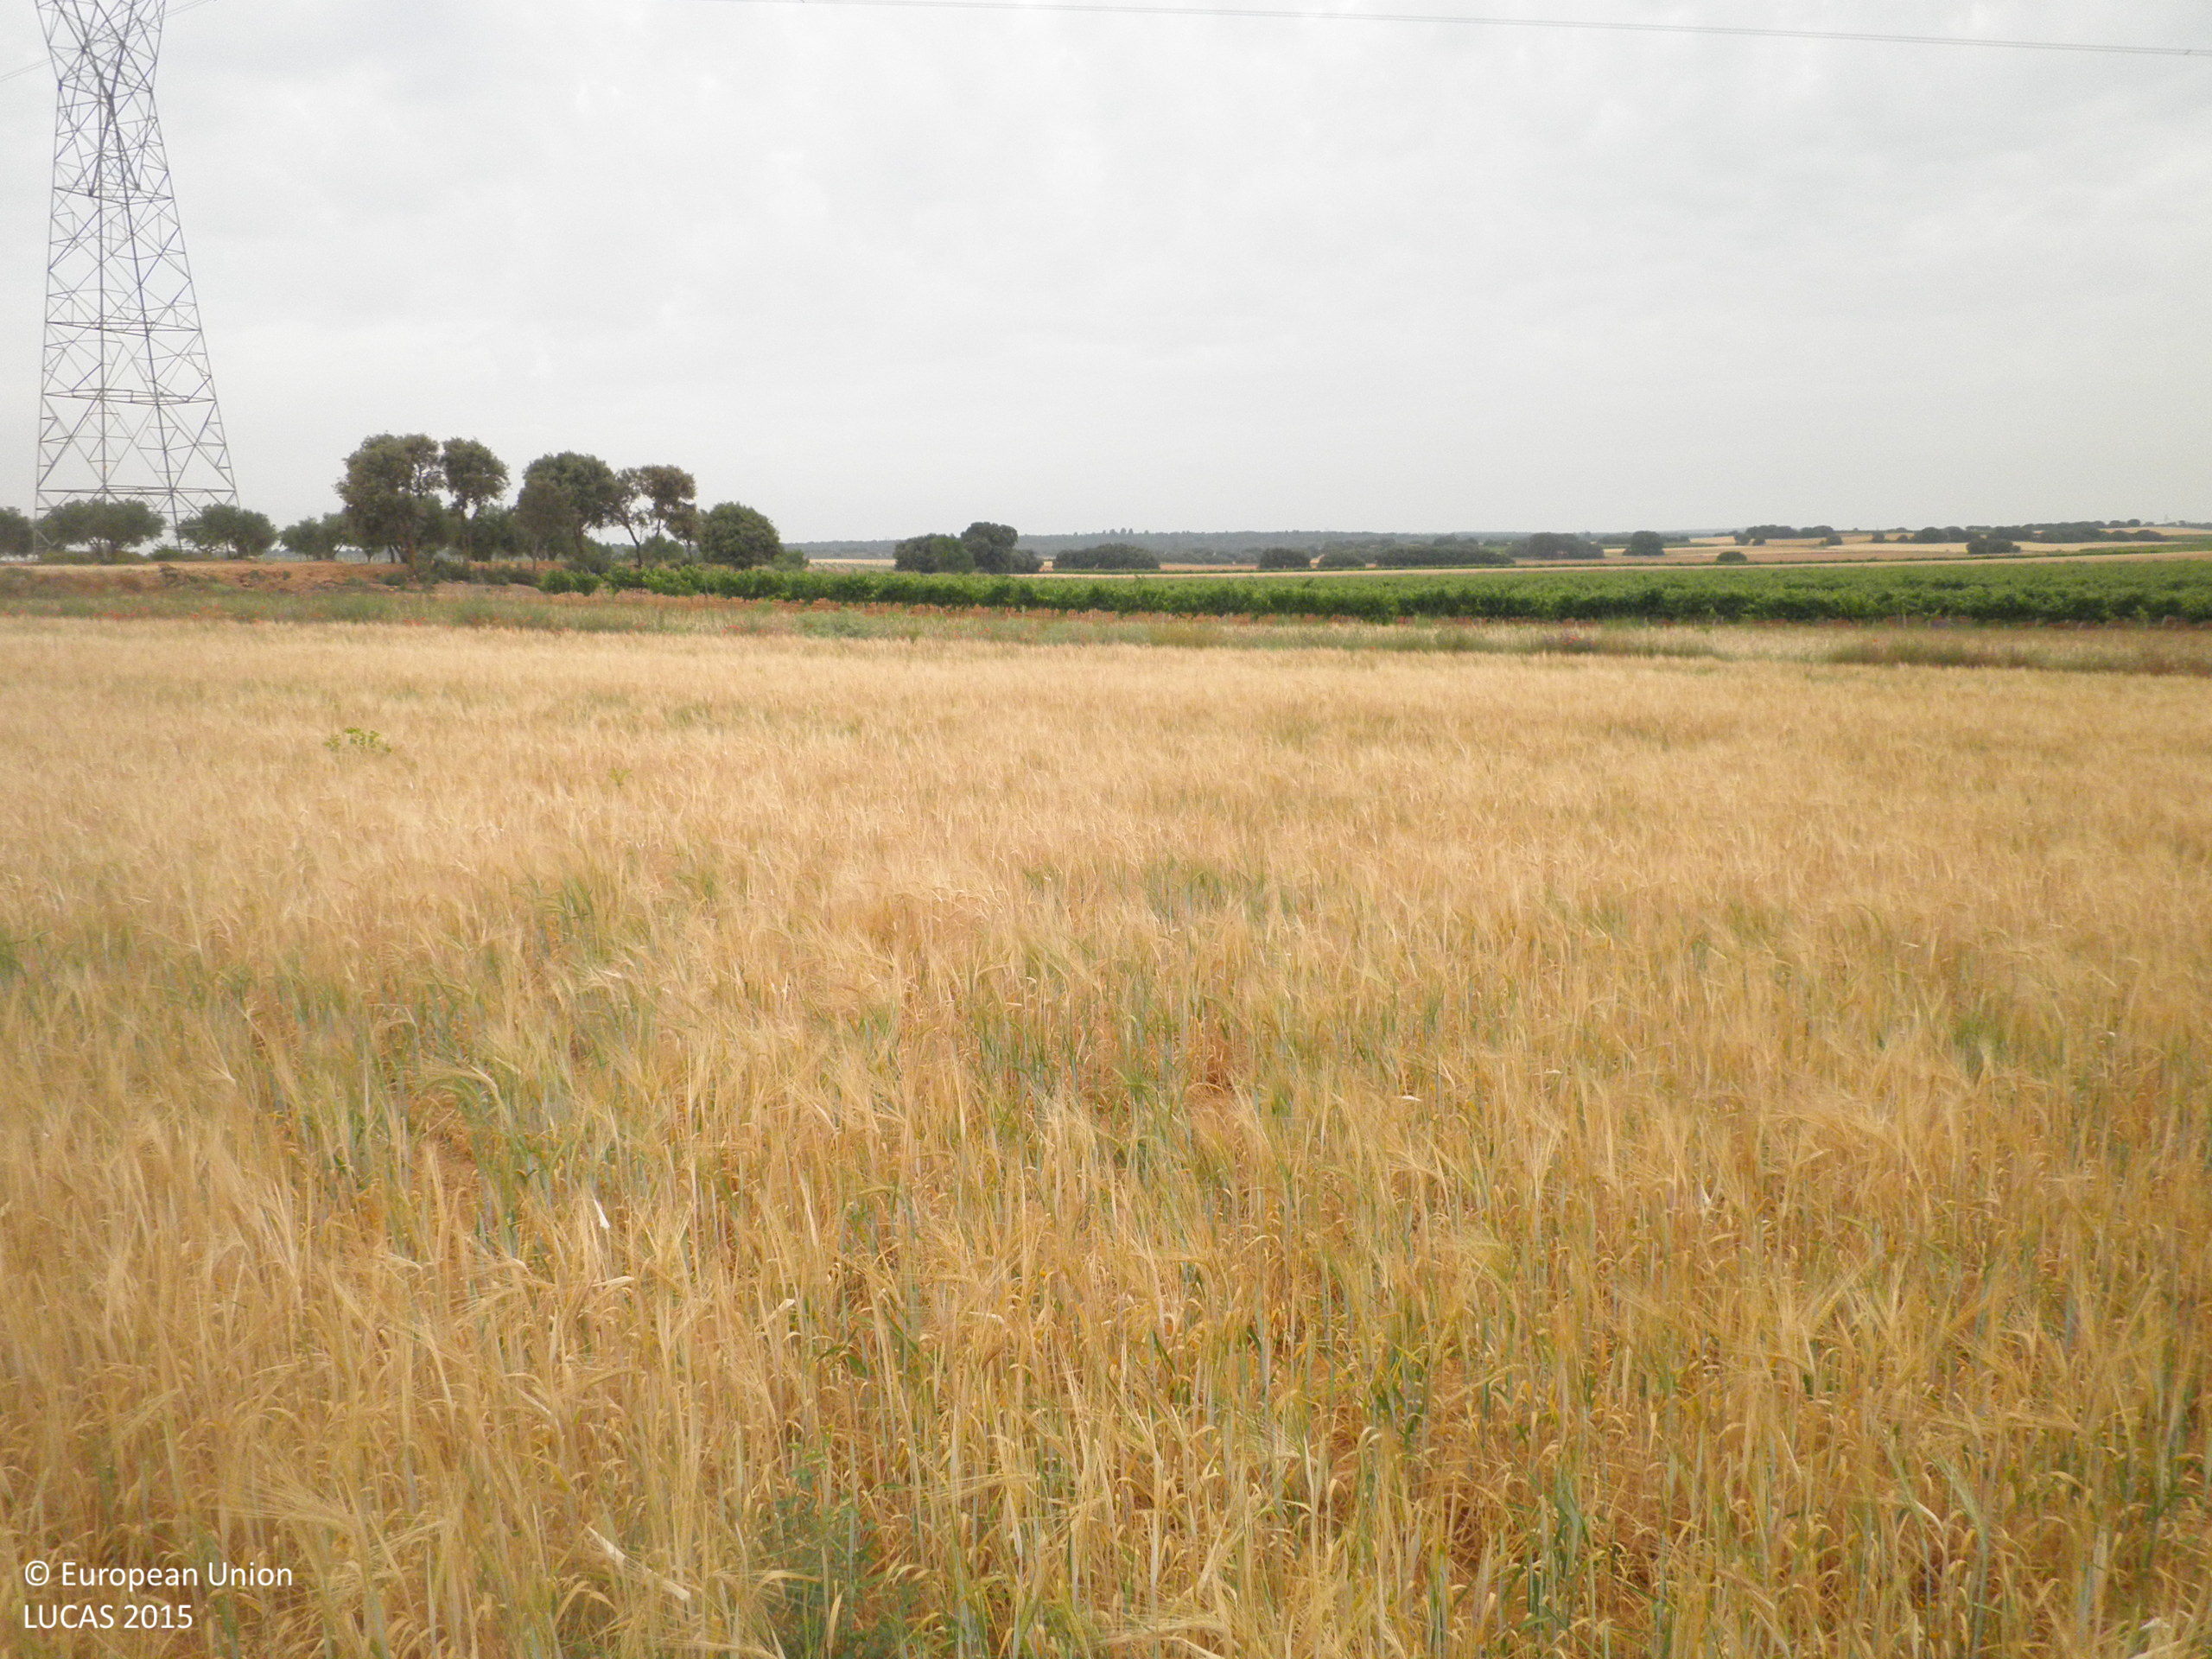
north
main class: Cropland
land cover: Barley
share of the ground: > 75 %
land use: Agriculture (excluding fallow land and kitchen gardens)
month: June
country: ES
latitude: 39.5257
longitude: -1.7206
